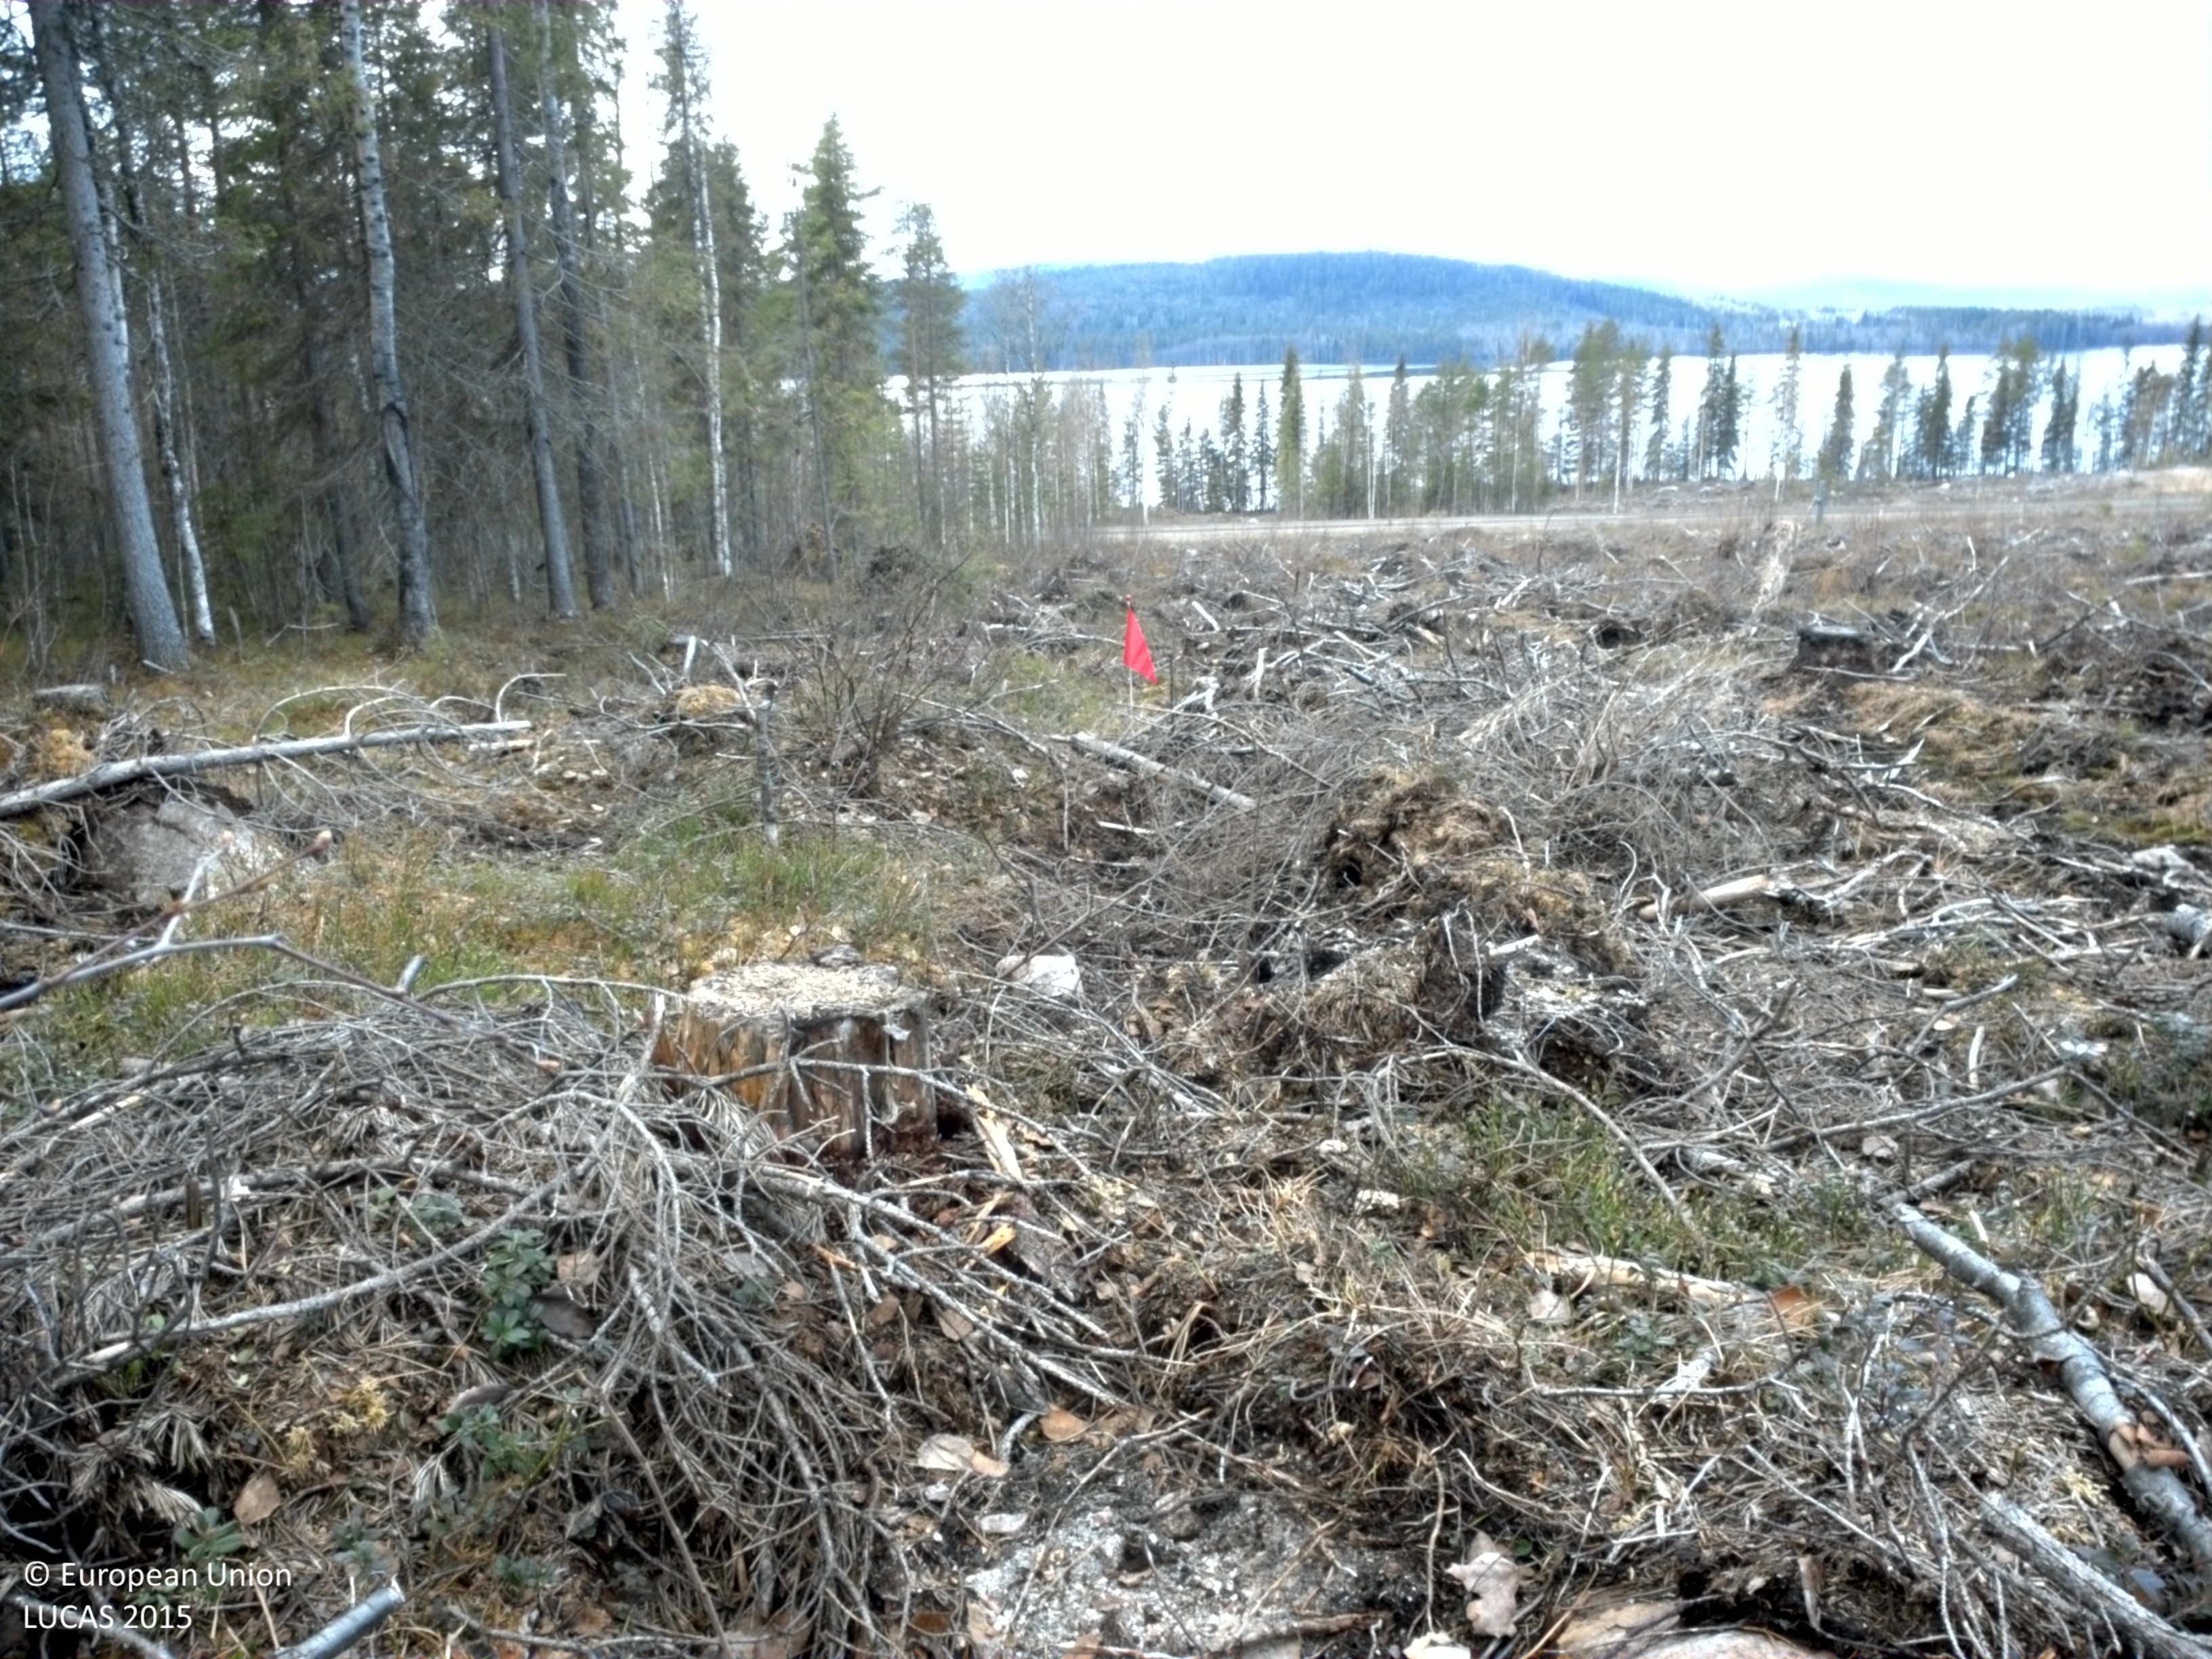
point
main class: Shrubland
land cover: Shrubland with sparse tree cover
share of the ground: 10 - 25 %
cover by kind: shrubs 20 %, unconsolidated bare surface 15 %, broadleaved forest trees 5 %, lichens and mosses 5 %
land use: Forestry
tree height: < 5 m
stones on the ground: 10 - 25 %
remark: Clear cut
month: May
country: SE
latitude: 66.3358
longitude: 23.5395
